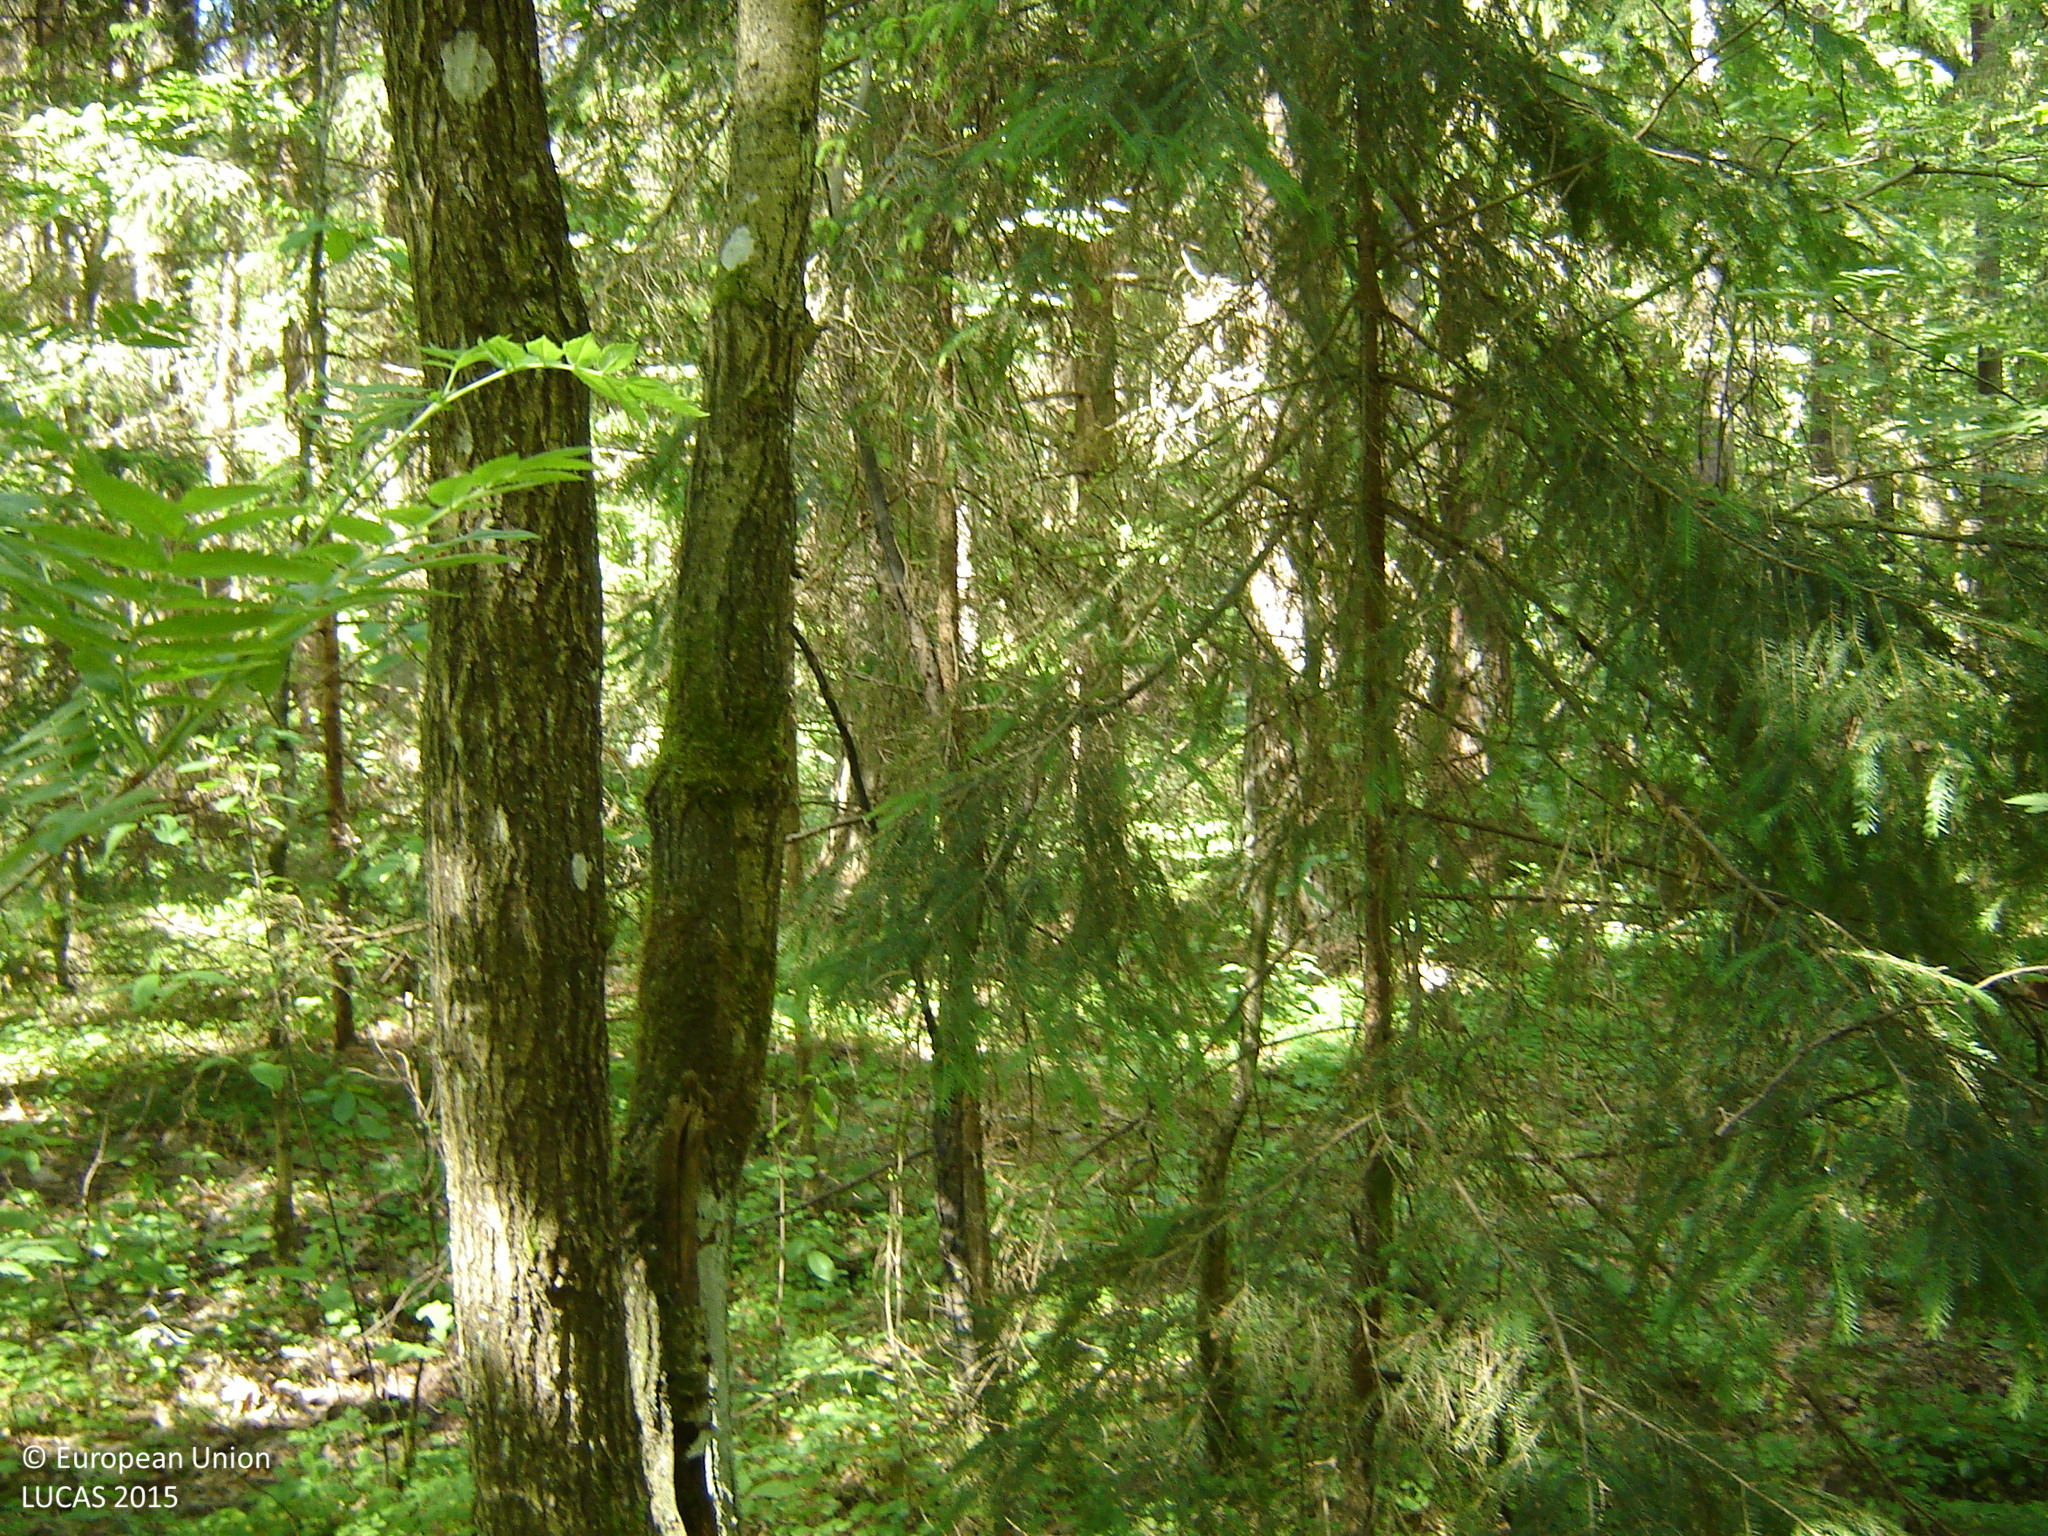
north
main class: Woodland
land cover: Other mixed woodland
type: hemiboreal forest and nemoral coniferous forest and mixed broadleaved-coniferous forest
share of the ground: > 75 %
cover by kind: coniferous forest trees 65 %, broadleaved forest trees 30 %, herbaceous plants 5 %
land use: Forestry
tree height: > 5 m
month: June
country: LT
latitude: 55.5581
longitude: 25.1286
